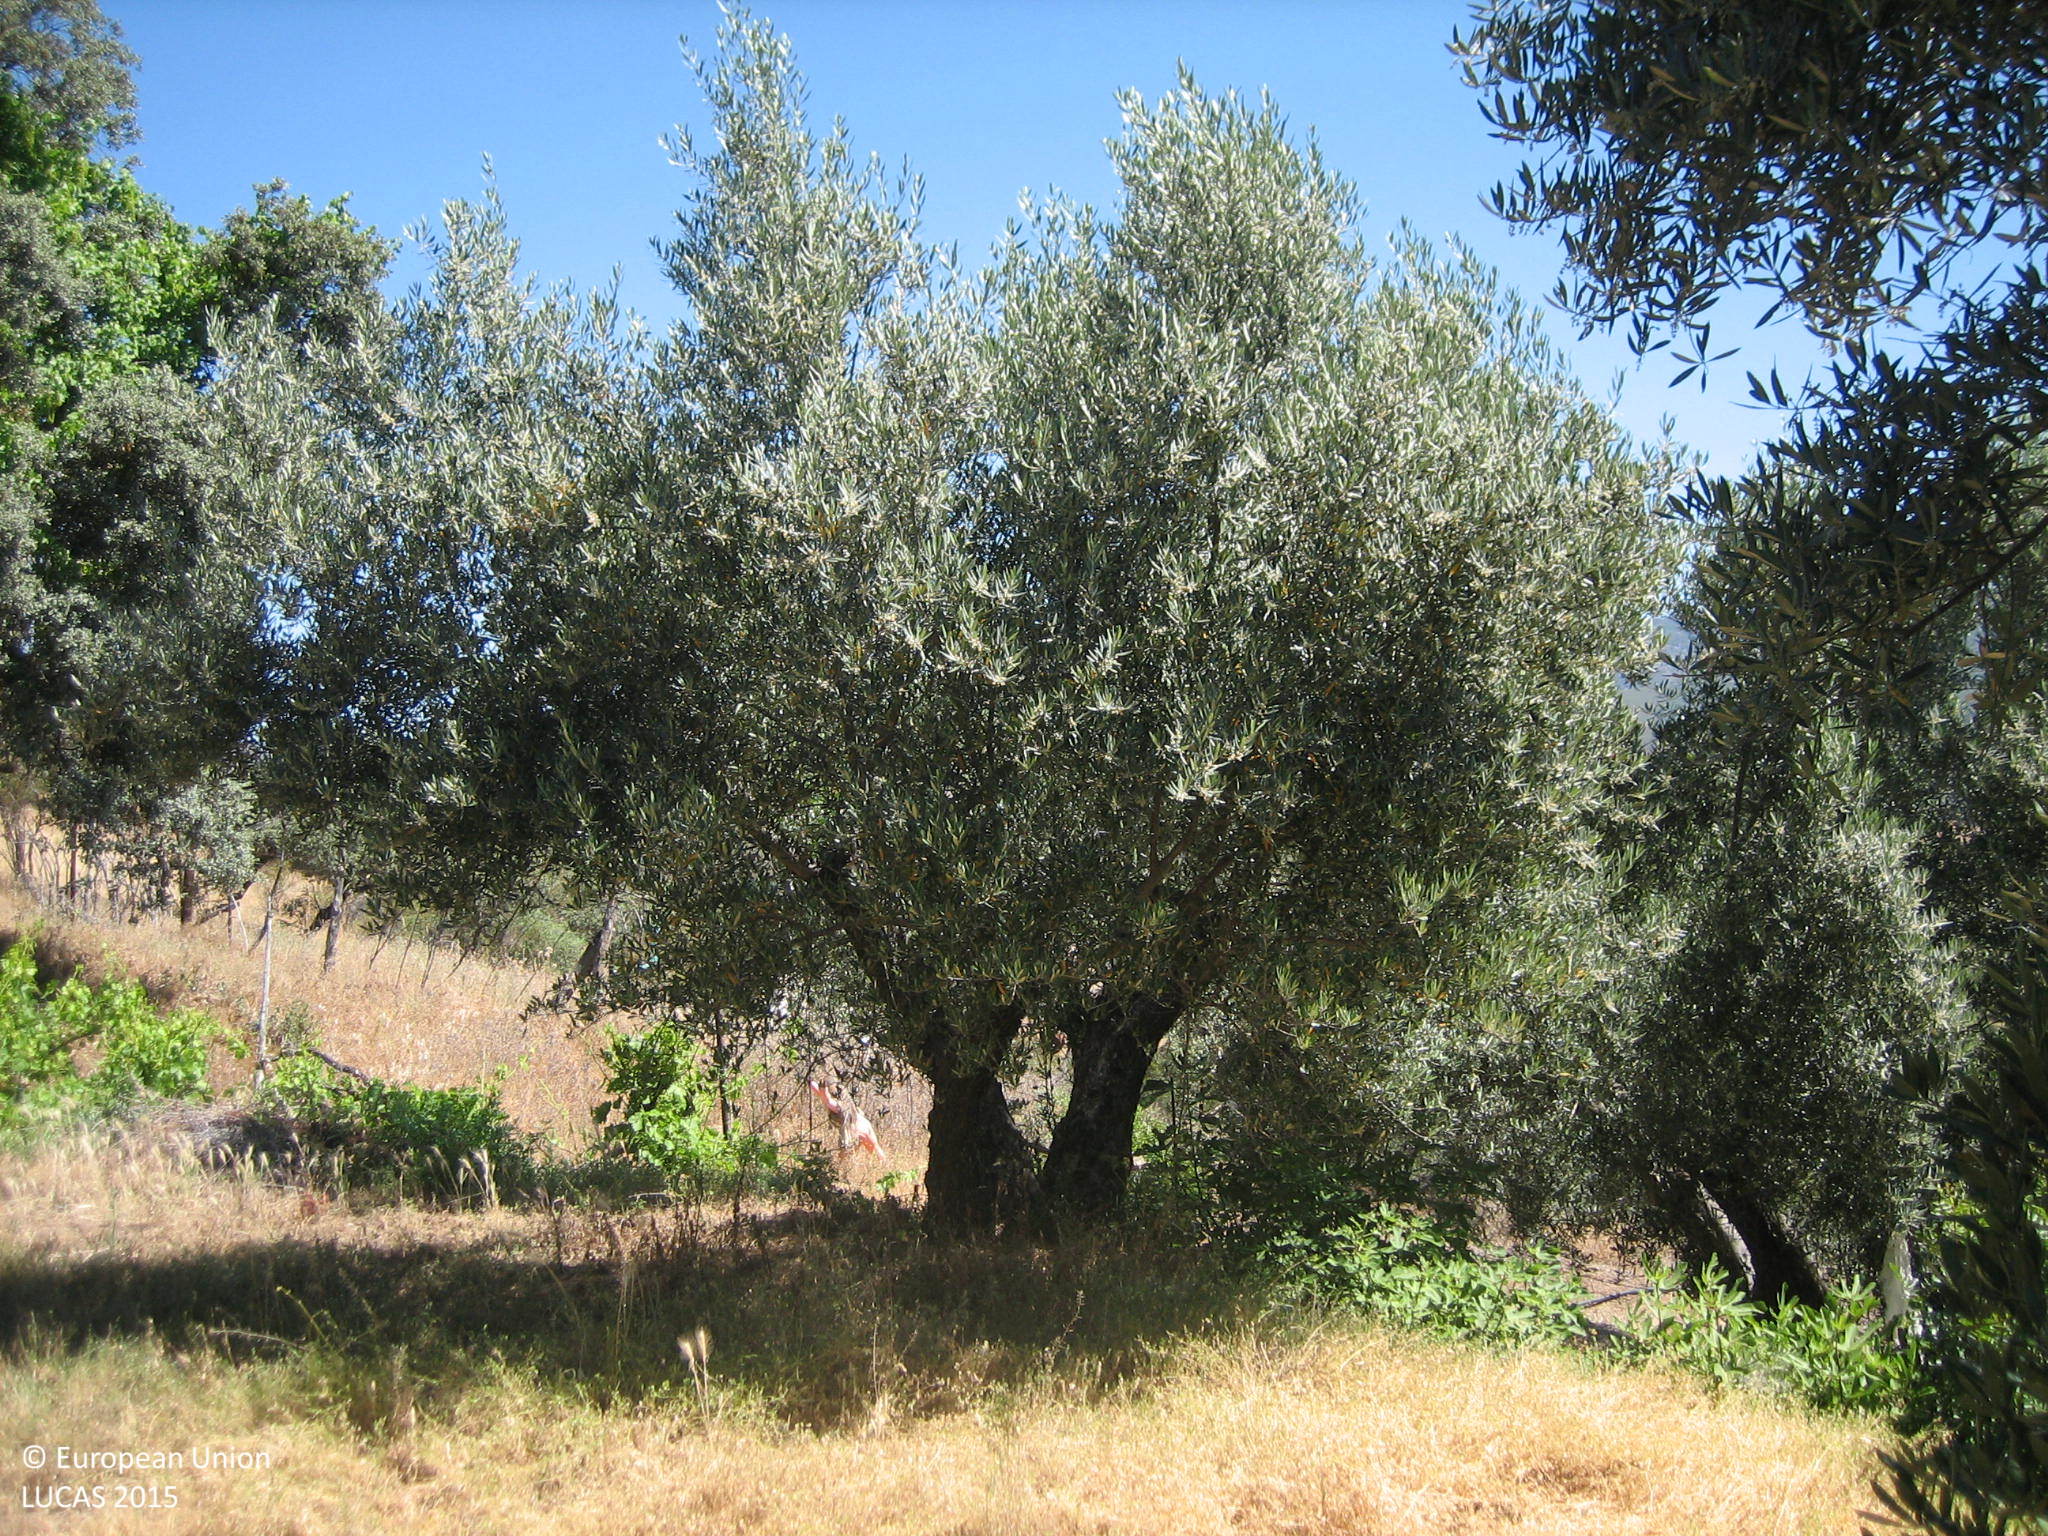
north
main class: Cropland
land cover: Olive groves
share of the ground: 50 - 75 %
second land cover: Grassland without tree/shrub cover
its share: 50 - 75 %
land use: Agriculture (excluding fallow land and kitchen gardens)
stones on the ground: < 10 %
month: May
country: ES
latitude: 38.3857
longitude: -3.9443
